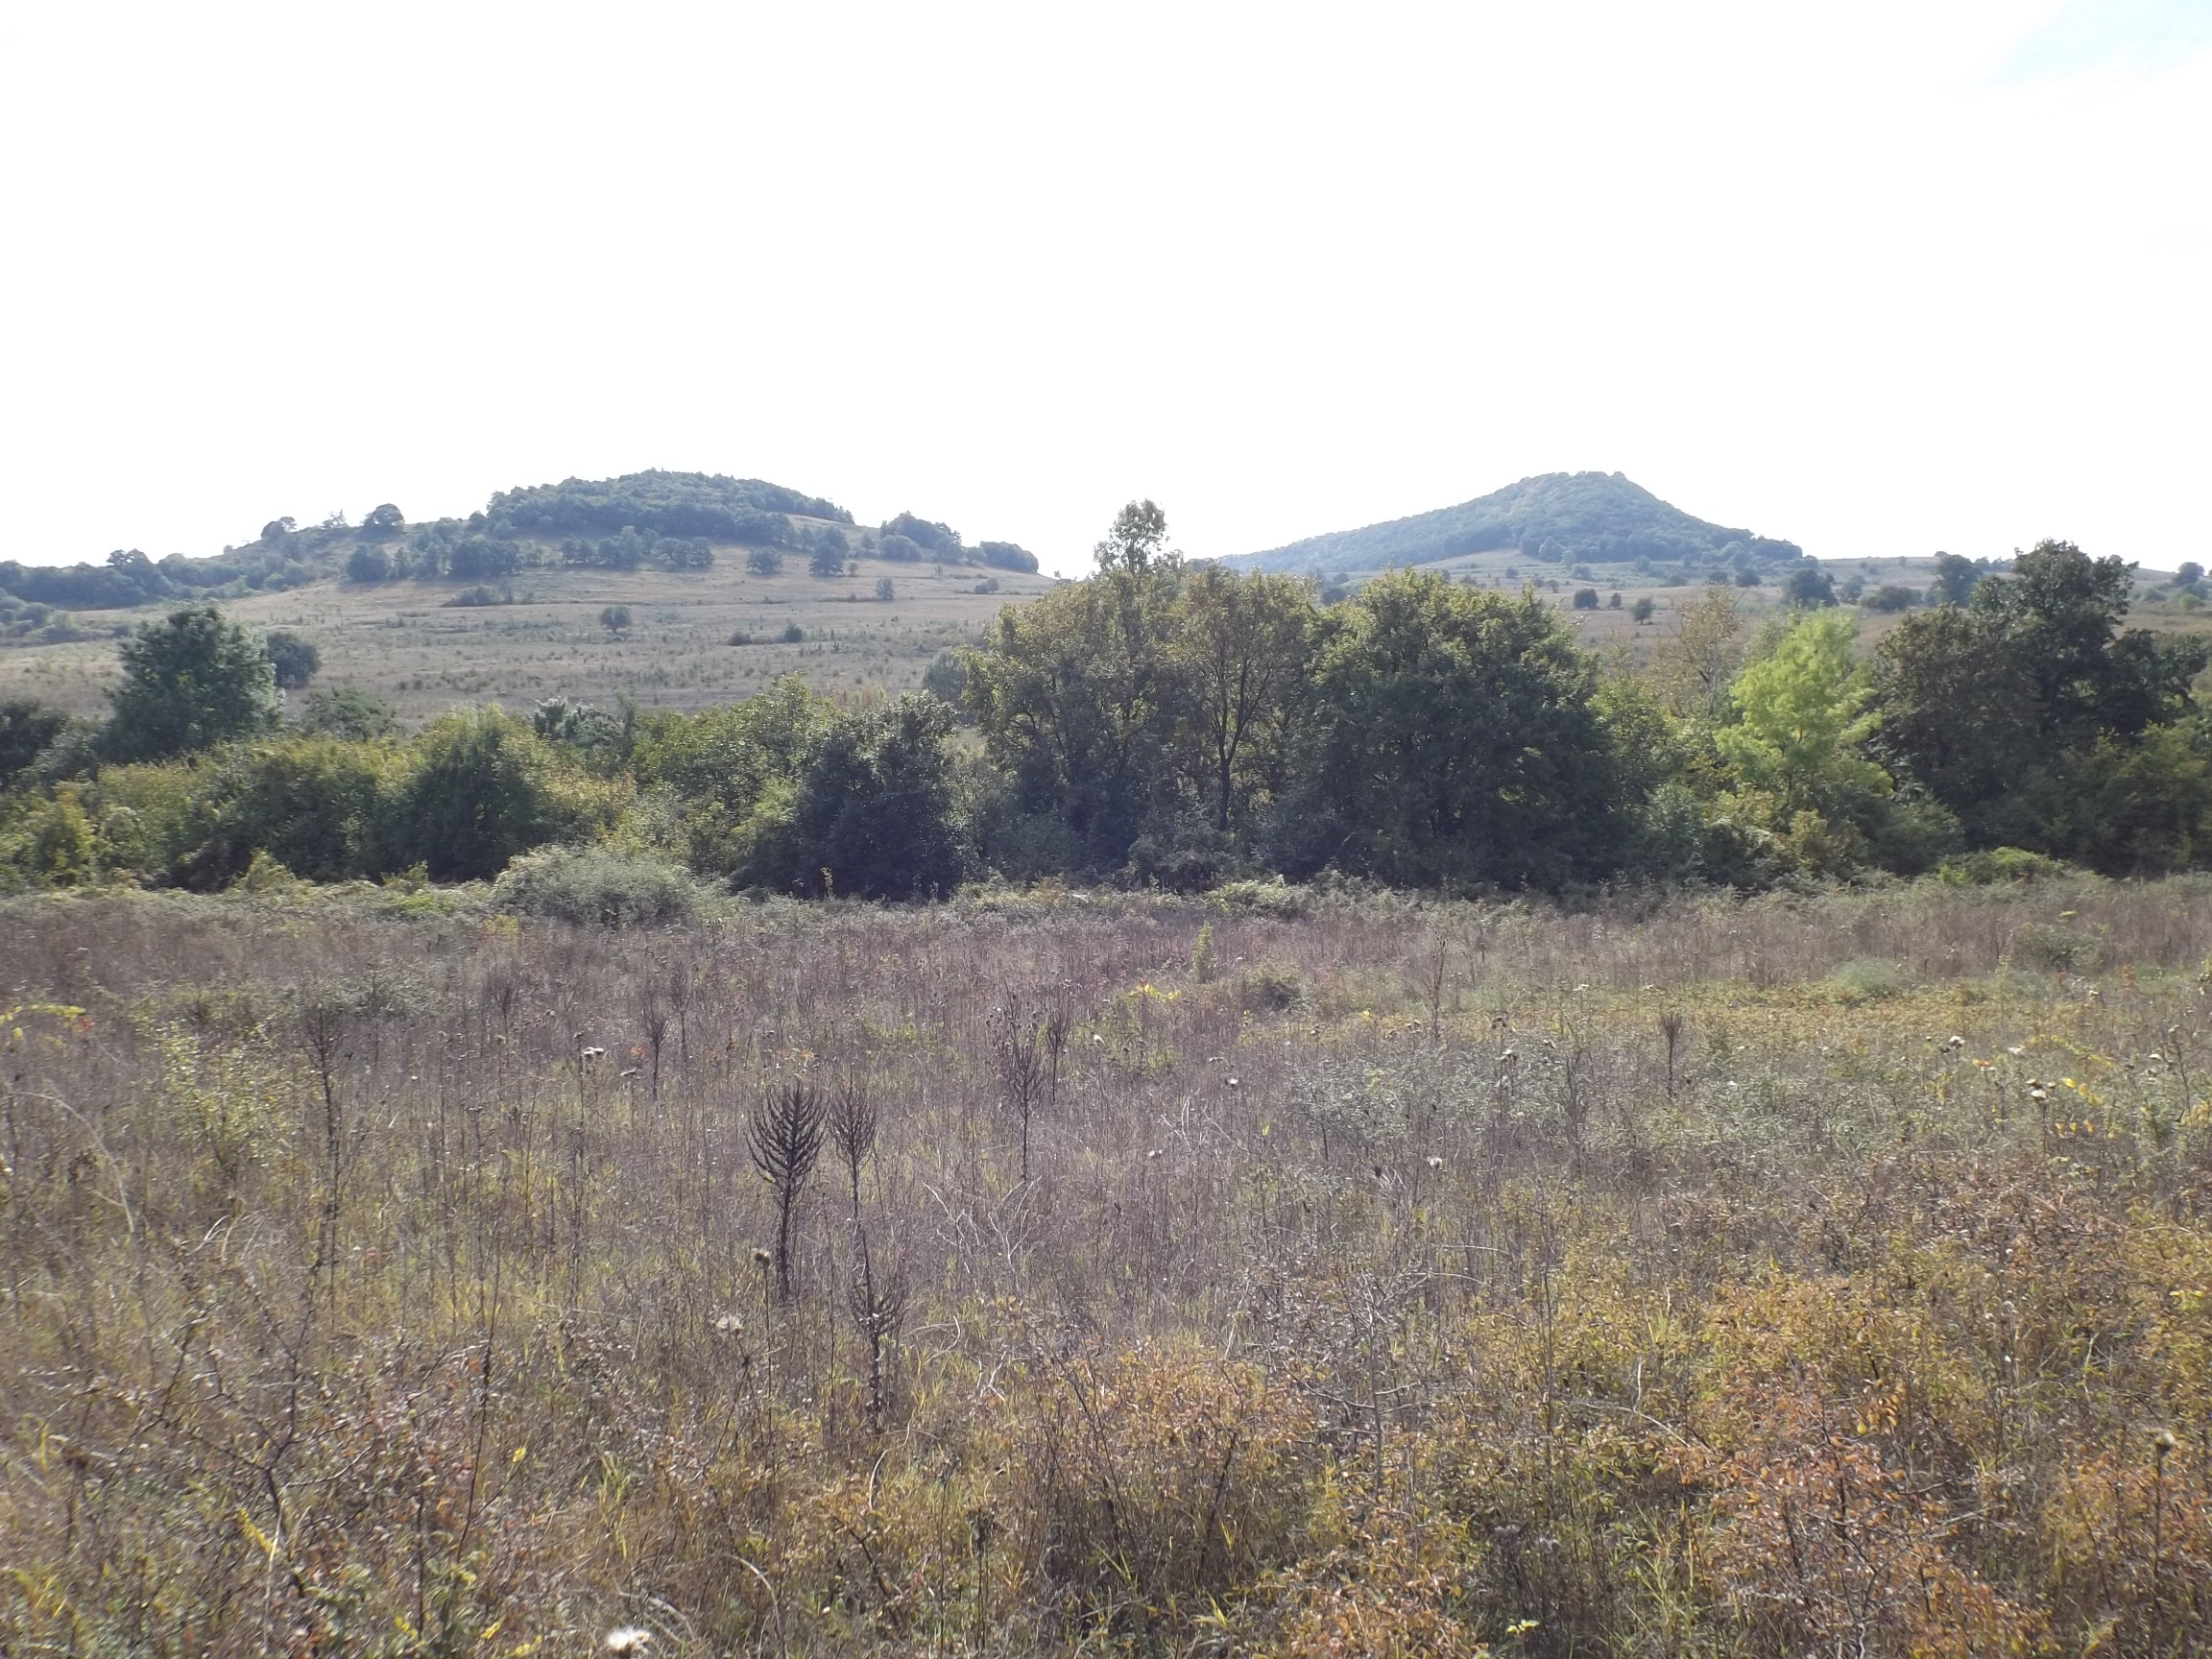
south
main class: Shrubland
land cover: Shrubland with sparse tree cover
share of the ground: > 75 %
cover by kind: shrubs 90 %, broadleaved forest trees 5 %, herbaceous plants 5 %
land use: Semi-natural and natural areas not in use
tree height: < 5 m
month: October
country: BG
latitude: 43.1196
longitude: 27.2146
